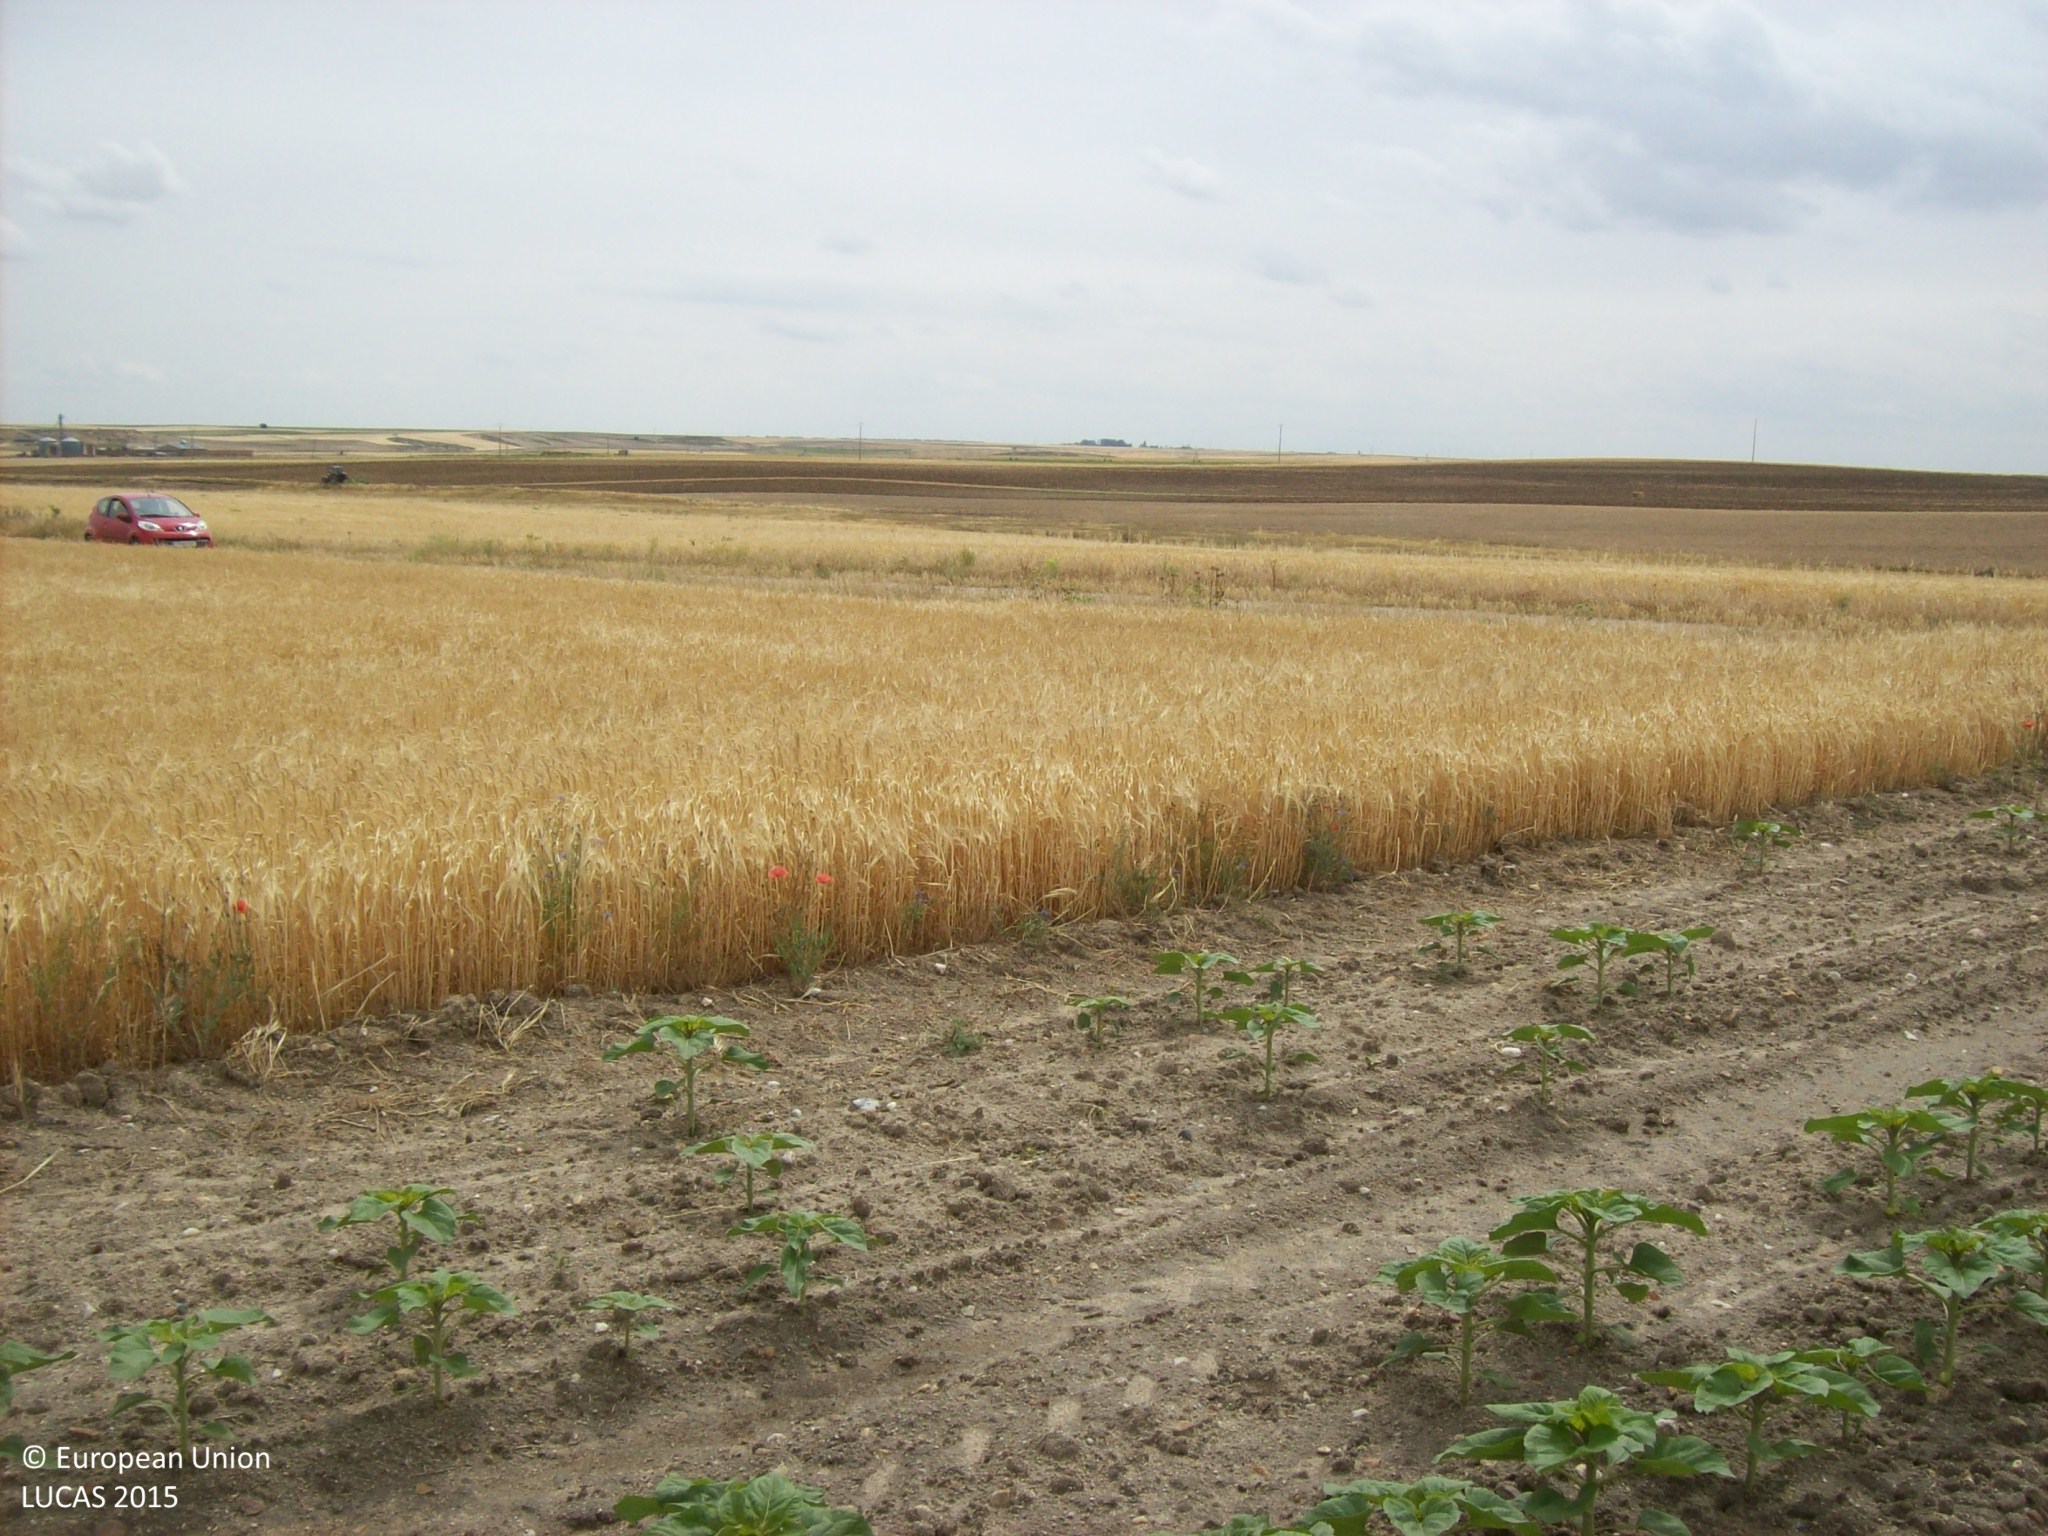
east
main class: Cropland
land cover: Sunflower
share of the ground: 50 - 75 %
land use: Agriculture (excluding fallow land and kitchen gardens)
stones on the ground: < 10 %
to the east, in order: Sunflower; Barley; Grass margins; Tracks; Grass margins; Barley; Grassland without tree/shrub cover; Other bare soil
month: June
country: ES
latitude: 40.9575
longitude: -5.0232
